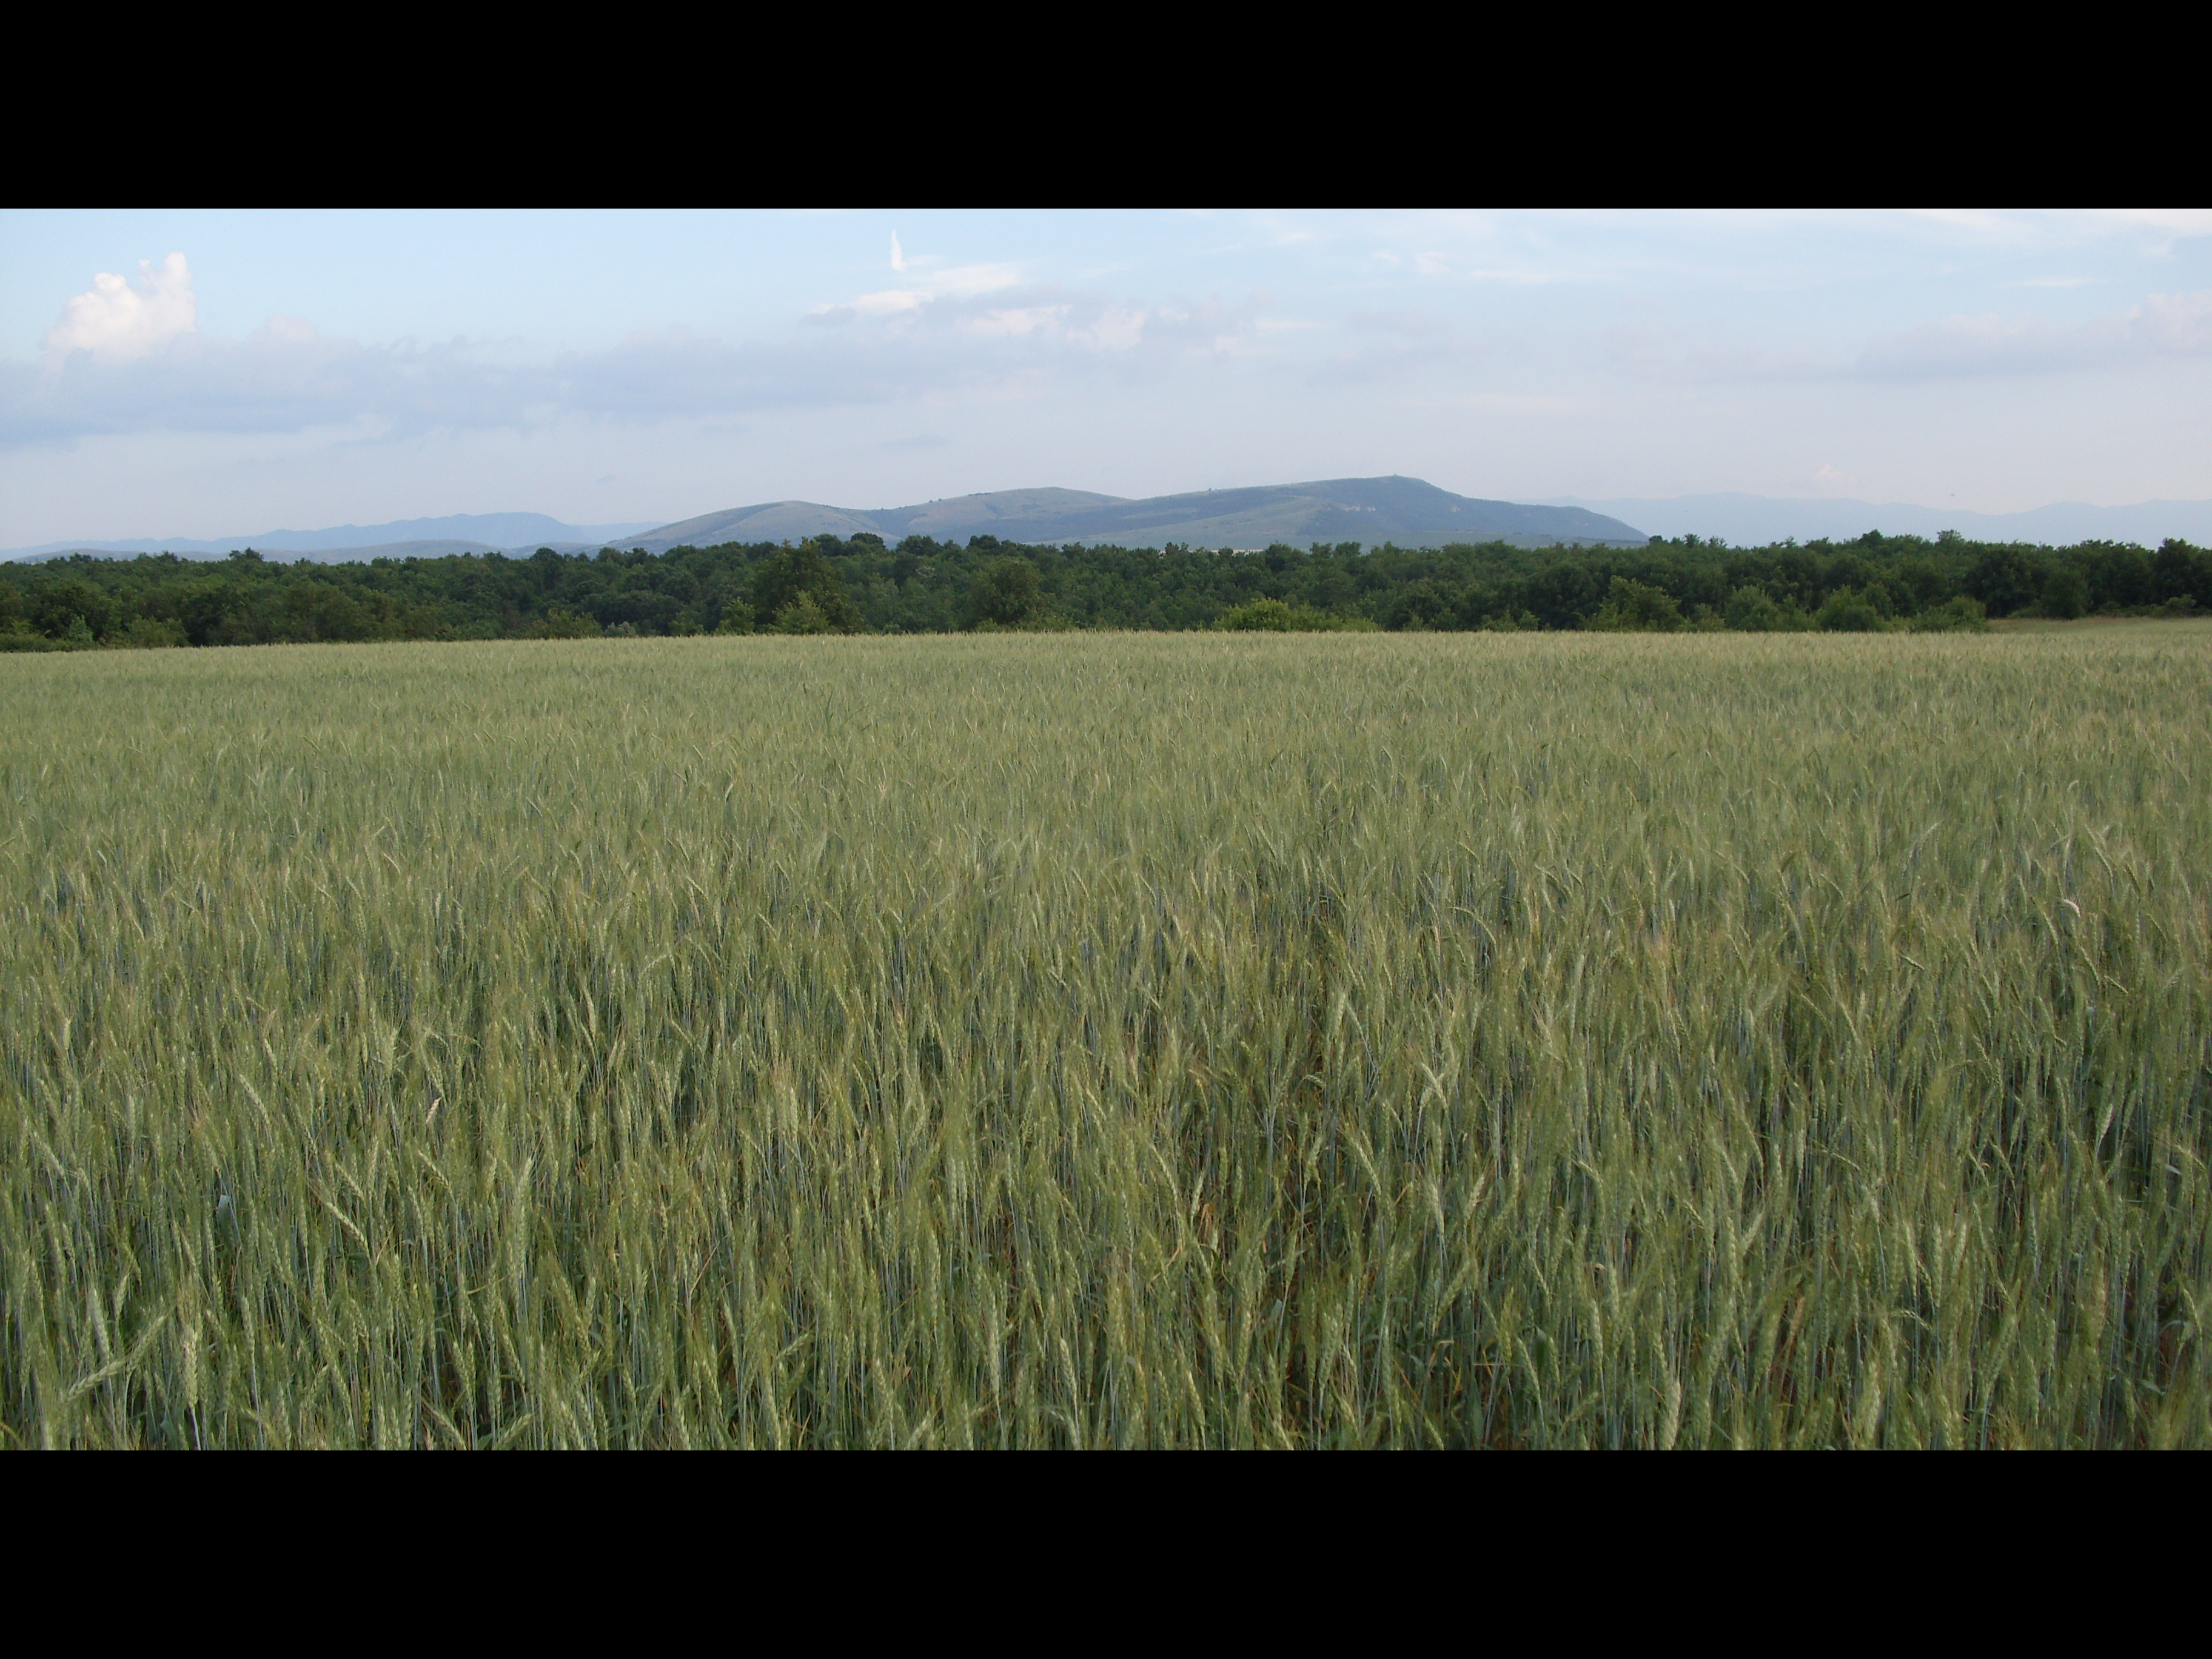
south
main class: Cropland
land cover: Common wheat
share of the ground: > 75 %
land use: Agriculture (excluding fallow land and kitchen gardens)
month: June
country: BG
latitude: 43.5066
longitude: 23.3136
